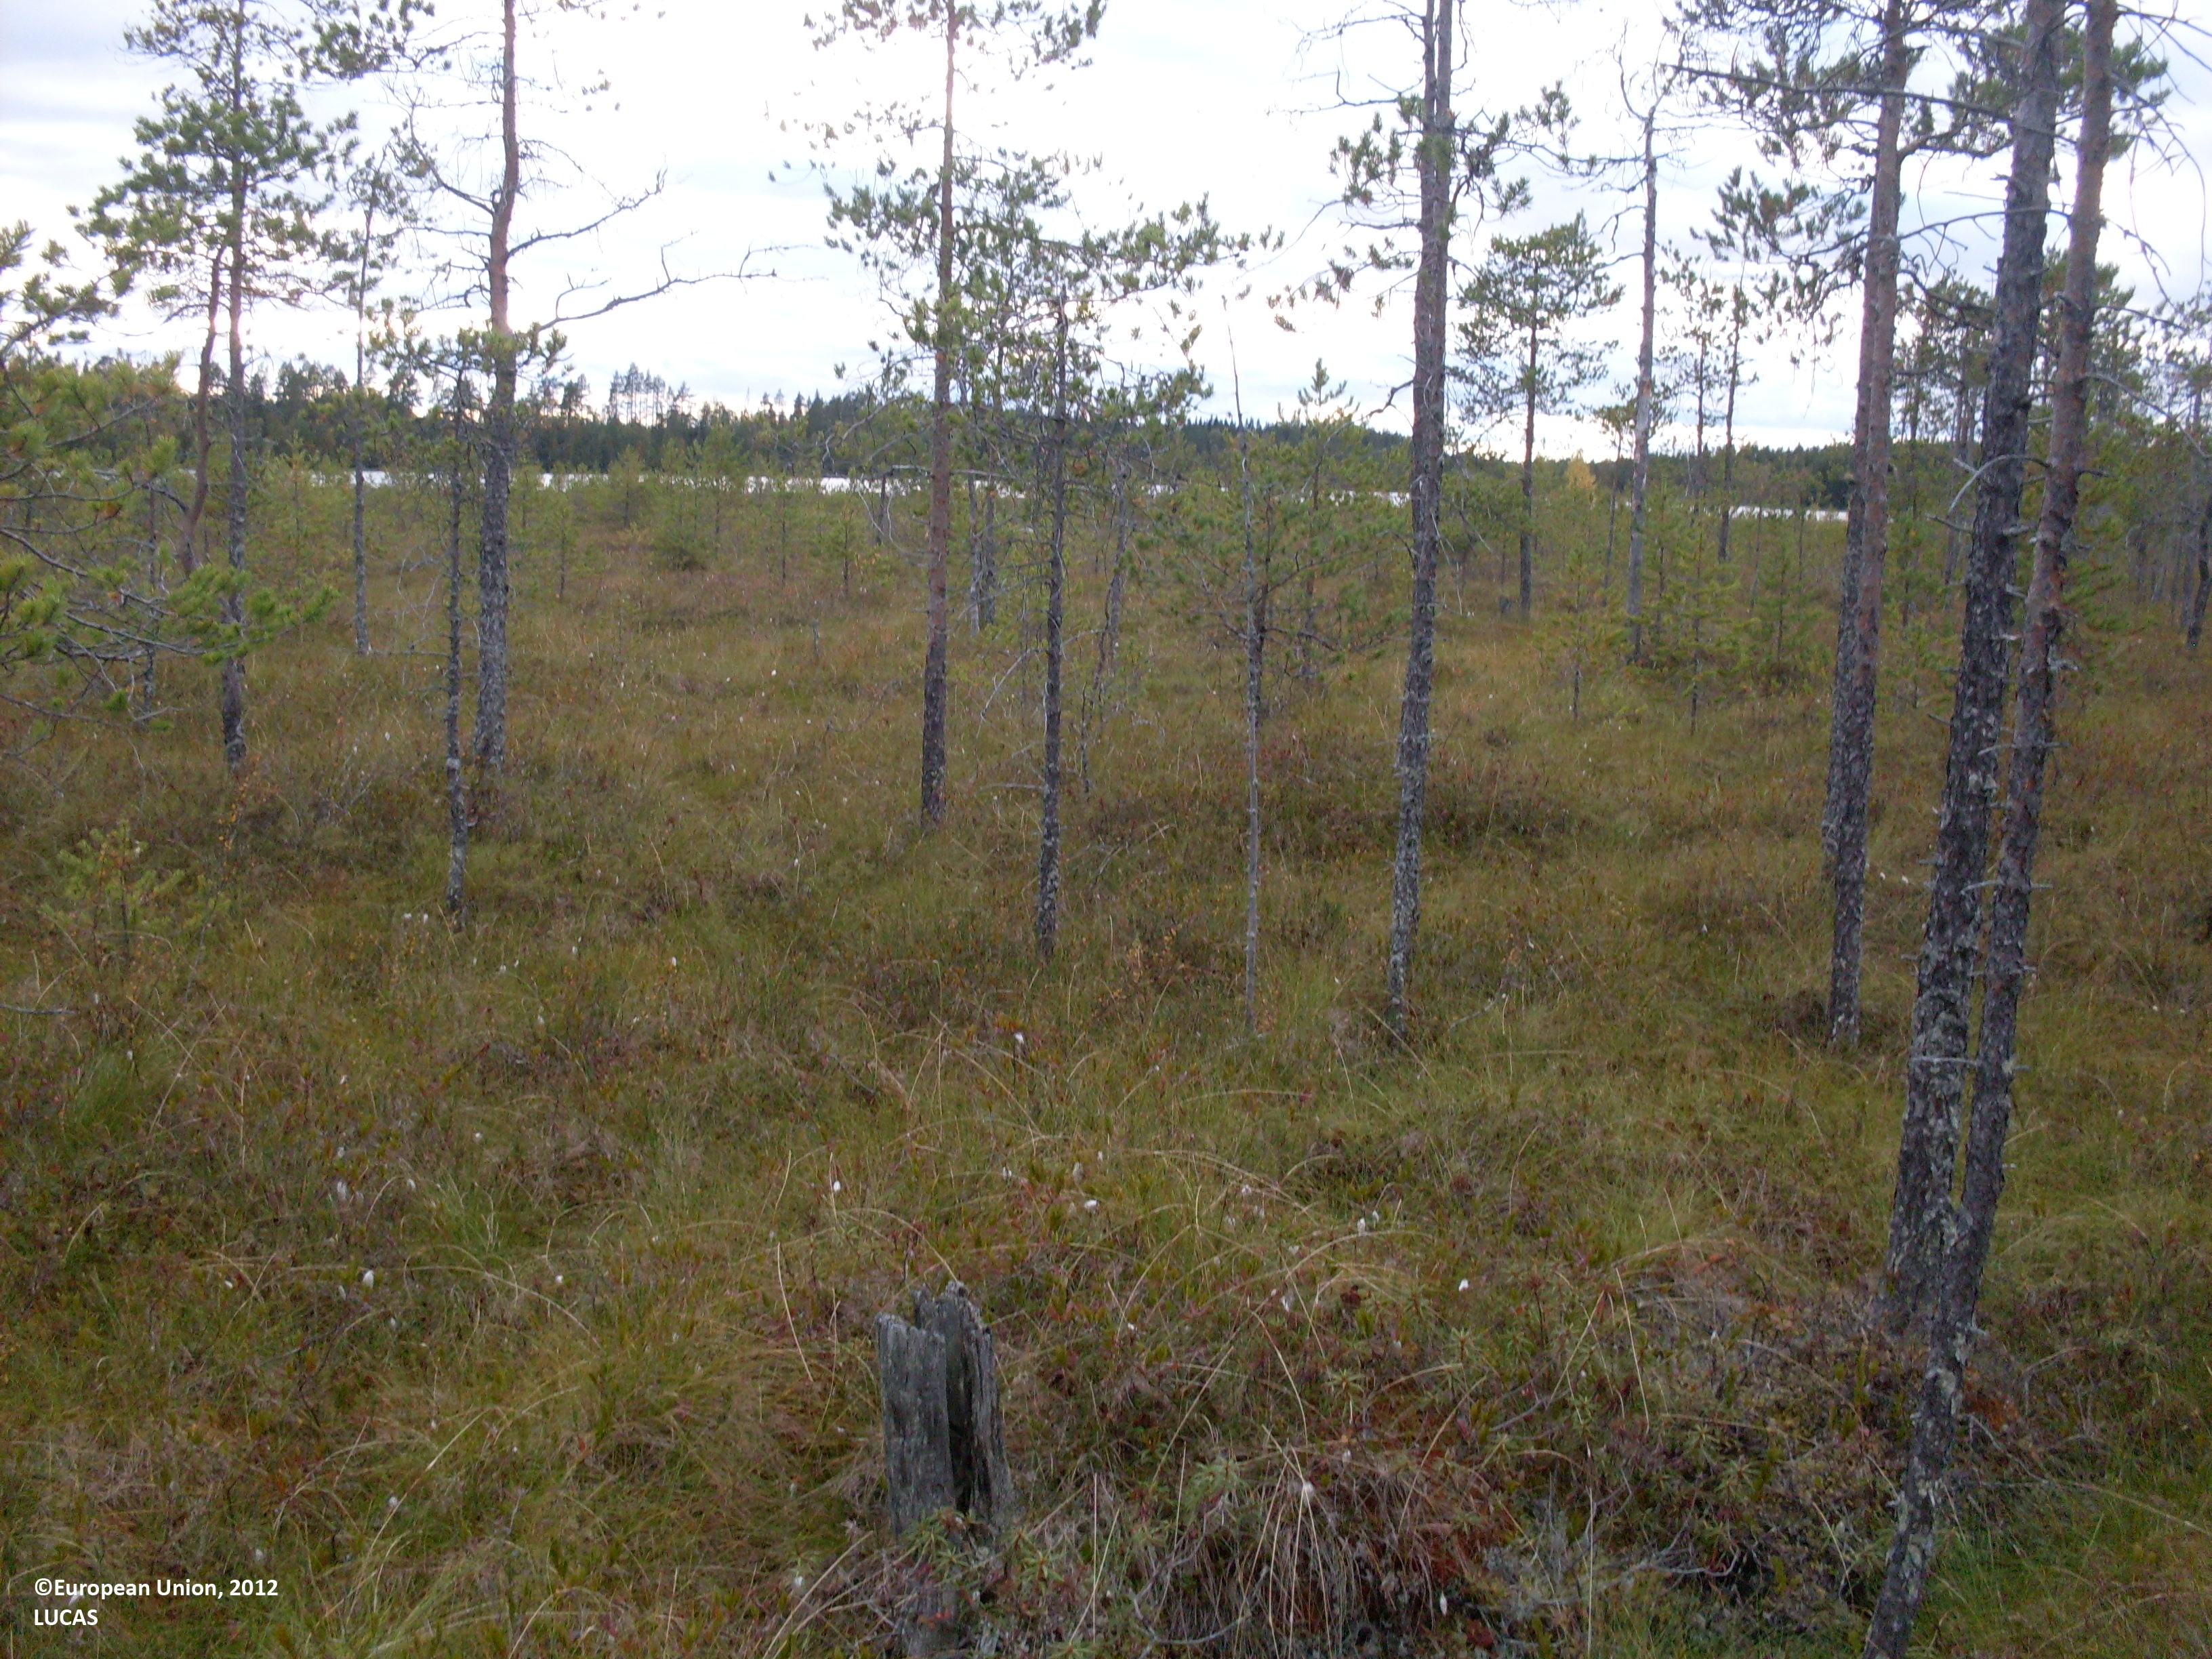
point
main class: Woodland
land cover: Pine dominated coniferous woodland
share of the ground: 10 - 25 %
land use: Semi-natural and natural areas not in use
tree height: < 5 m
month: September
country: FI
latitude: 64.1529
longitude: 29.2666
